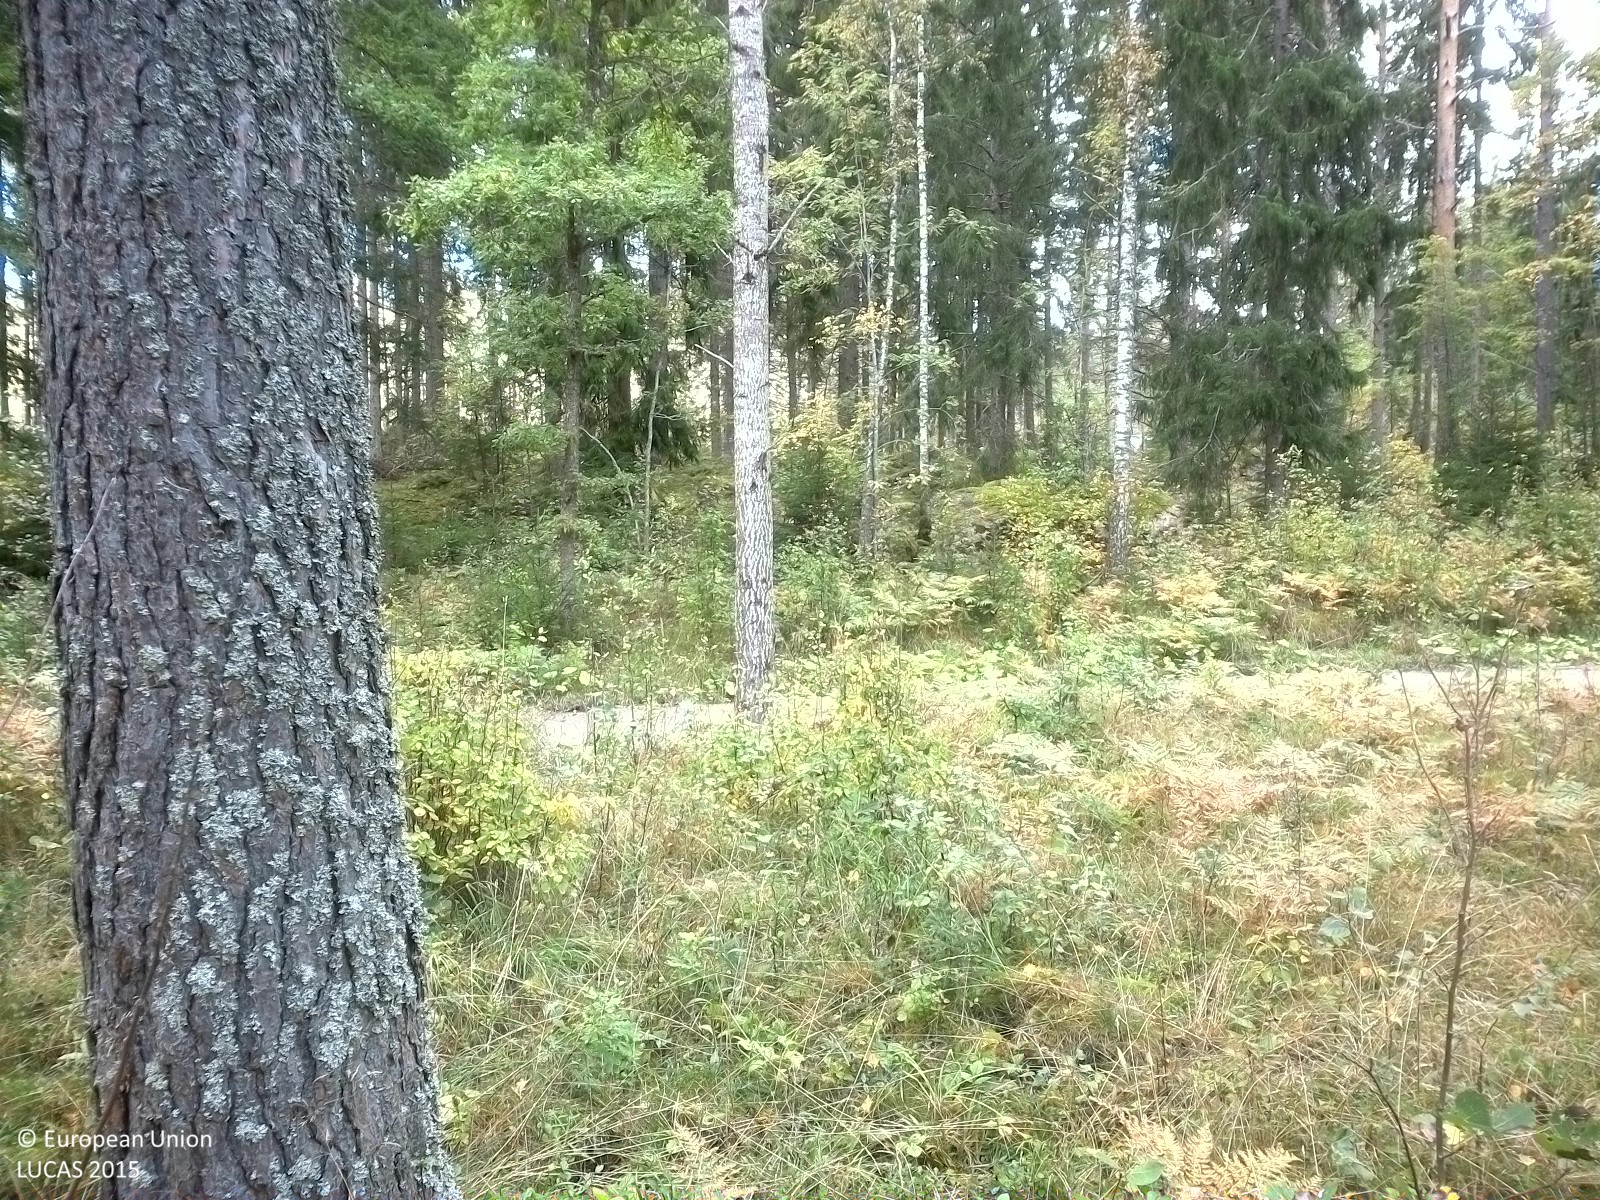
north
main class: Woodland
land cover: Pine dominated mixed woodland
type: boreal forest
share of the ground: 25 - 50 %
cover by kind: herbaceous plants 45 %, coniferous forest trees 25 %, broadleaved forest trees 15 %, shrubs 10 %, lichens and mosses 5 %
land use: Forestry
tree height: > 5 m
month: September
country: SE
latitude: 58.9223
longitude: 15.8465
